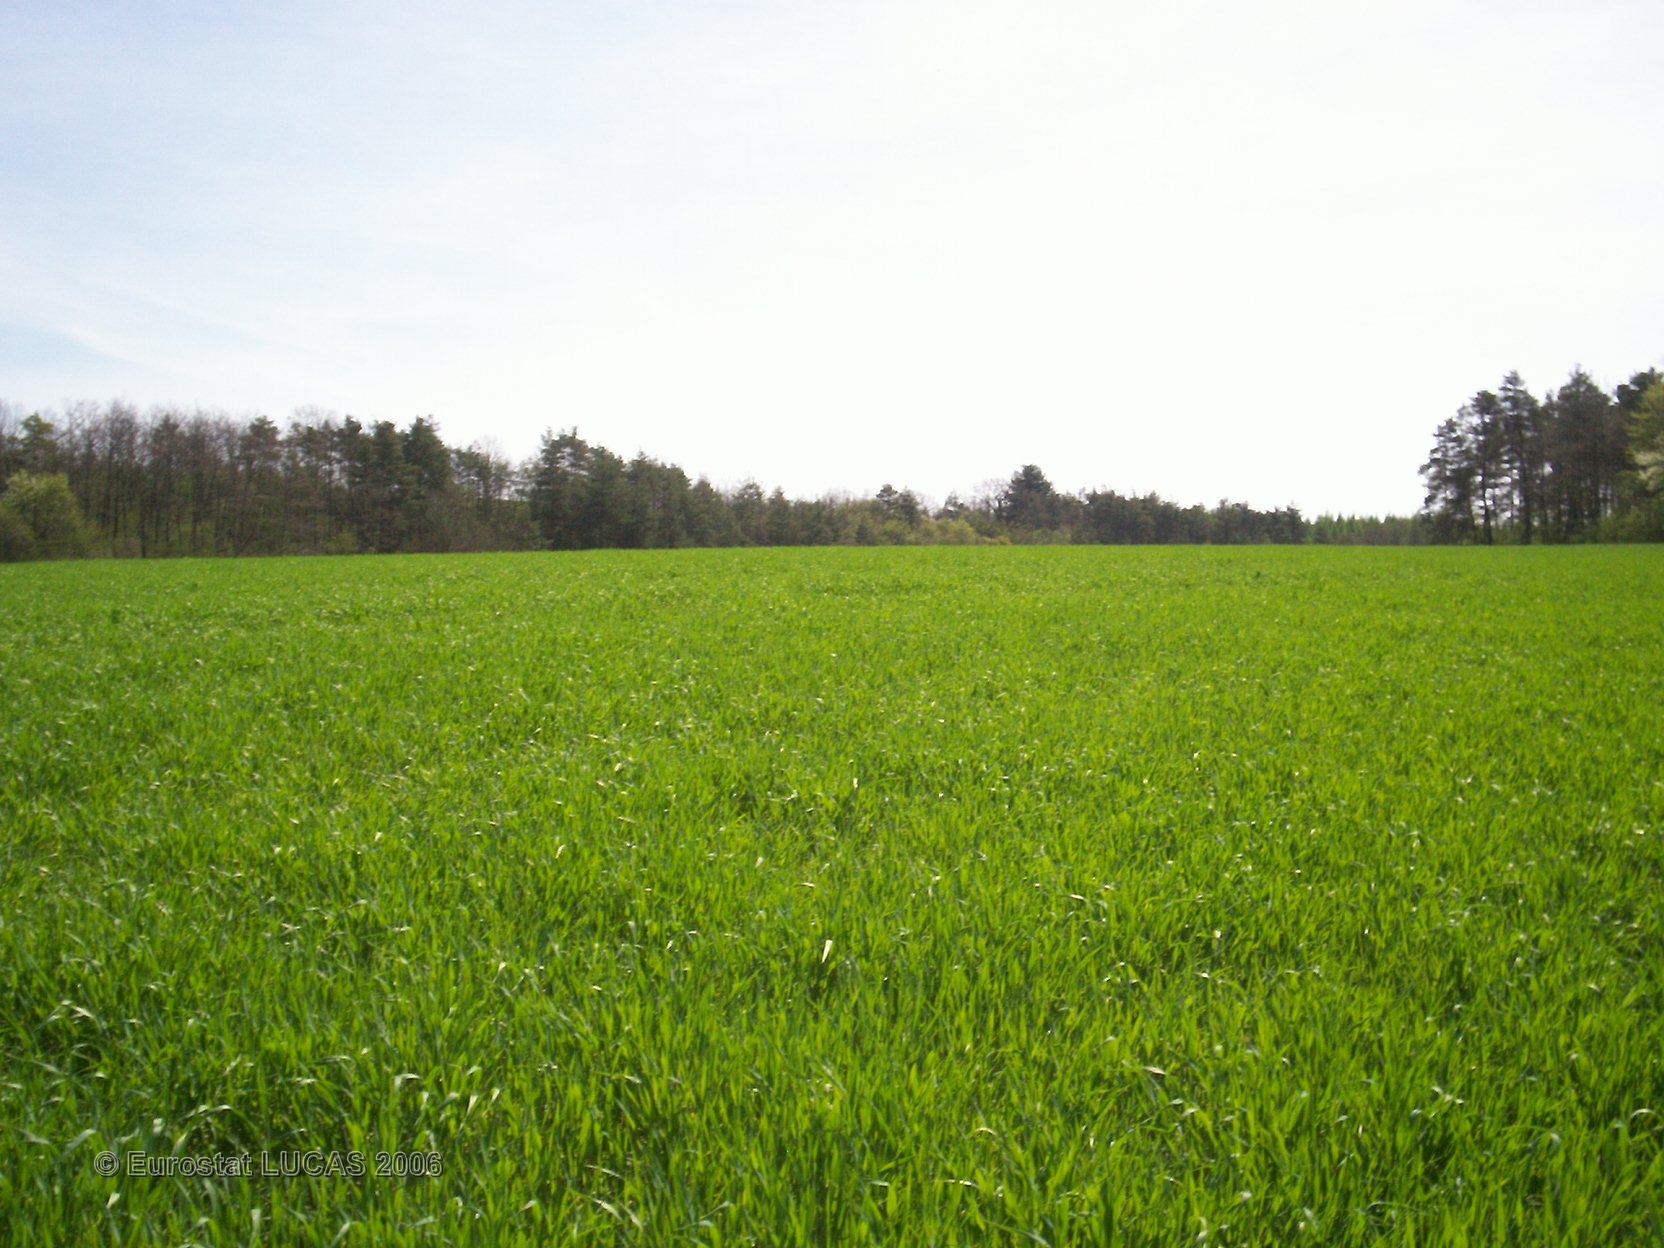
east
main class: Cropland
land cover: Barley
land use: Agriculture (excluding fallow land and kitchen gardens)
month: May
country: FR
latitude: 47.8355
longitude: 4.5341
